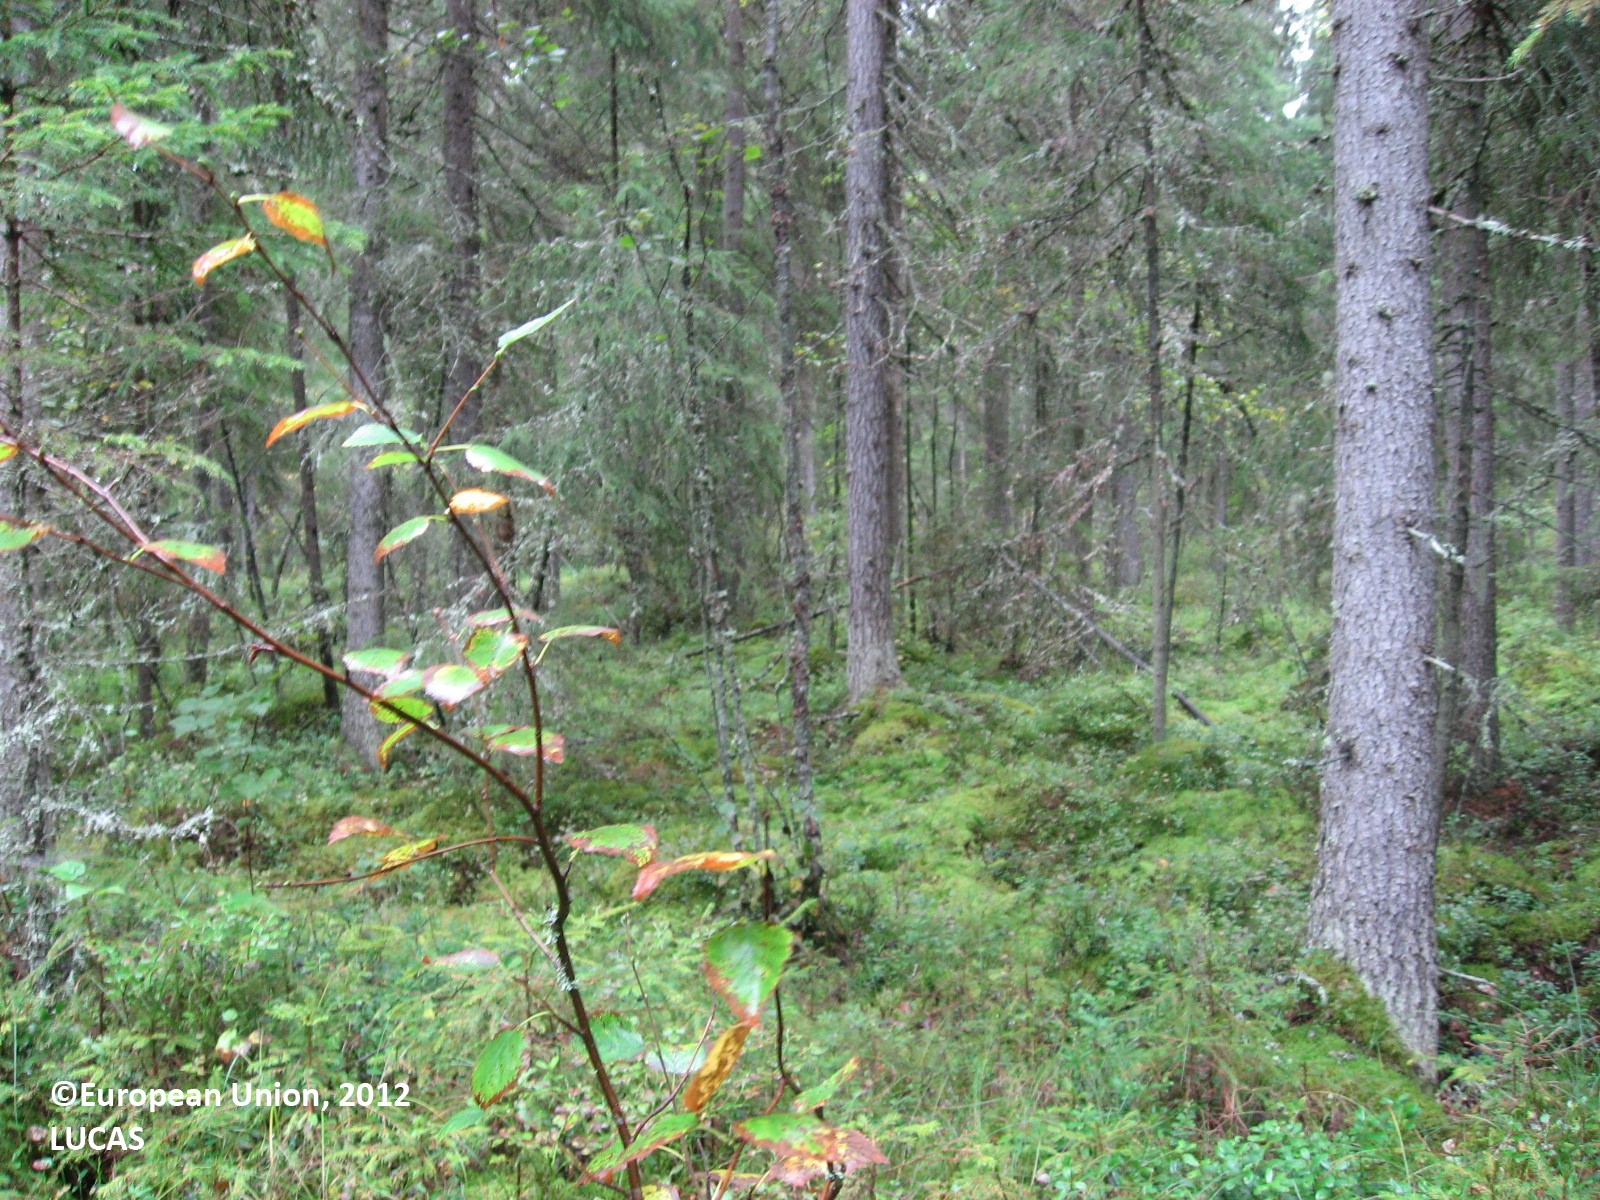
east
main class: Woodland
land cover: Spruce dominated mixed woodland
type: boreal forest
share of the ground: 50 - 75 %
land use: Forestry
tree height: > 5 m
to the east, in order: Spruce dominated mixed woodland; Ditches and canals; Spruce dominated coniferous woodland; Ditches and canals; Spruce dominated coniferous woodland; Ditches and canals; Spruce dominated coniferous woodland; Spruce dominated mixed woodland
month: August
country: FI
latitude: 61.4901
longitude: 24.9643
